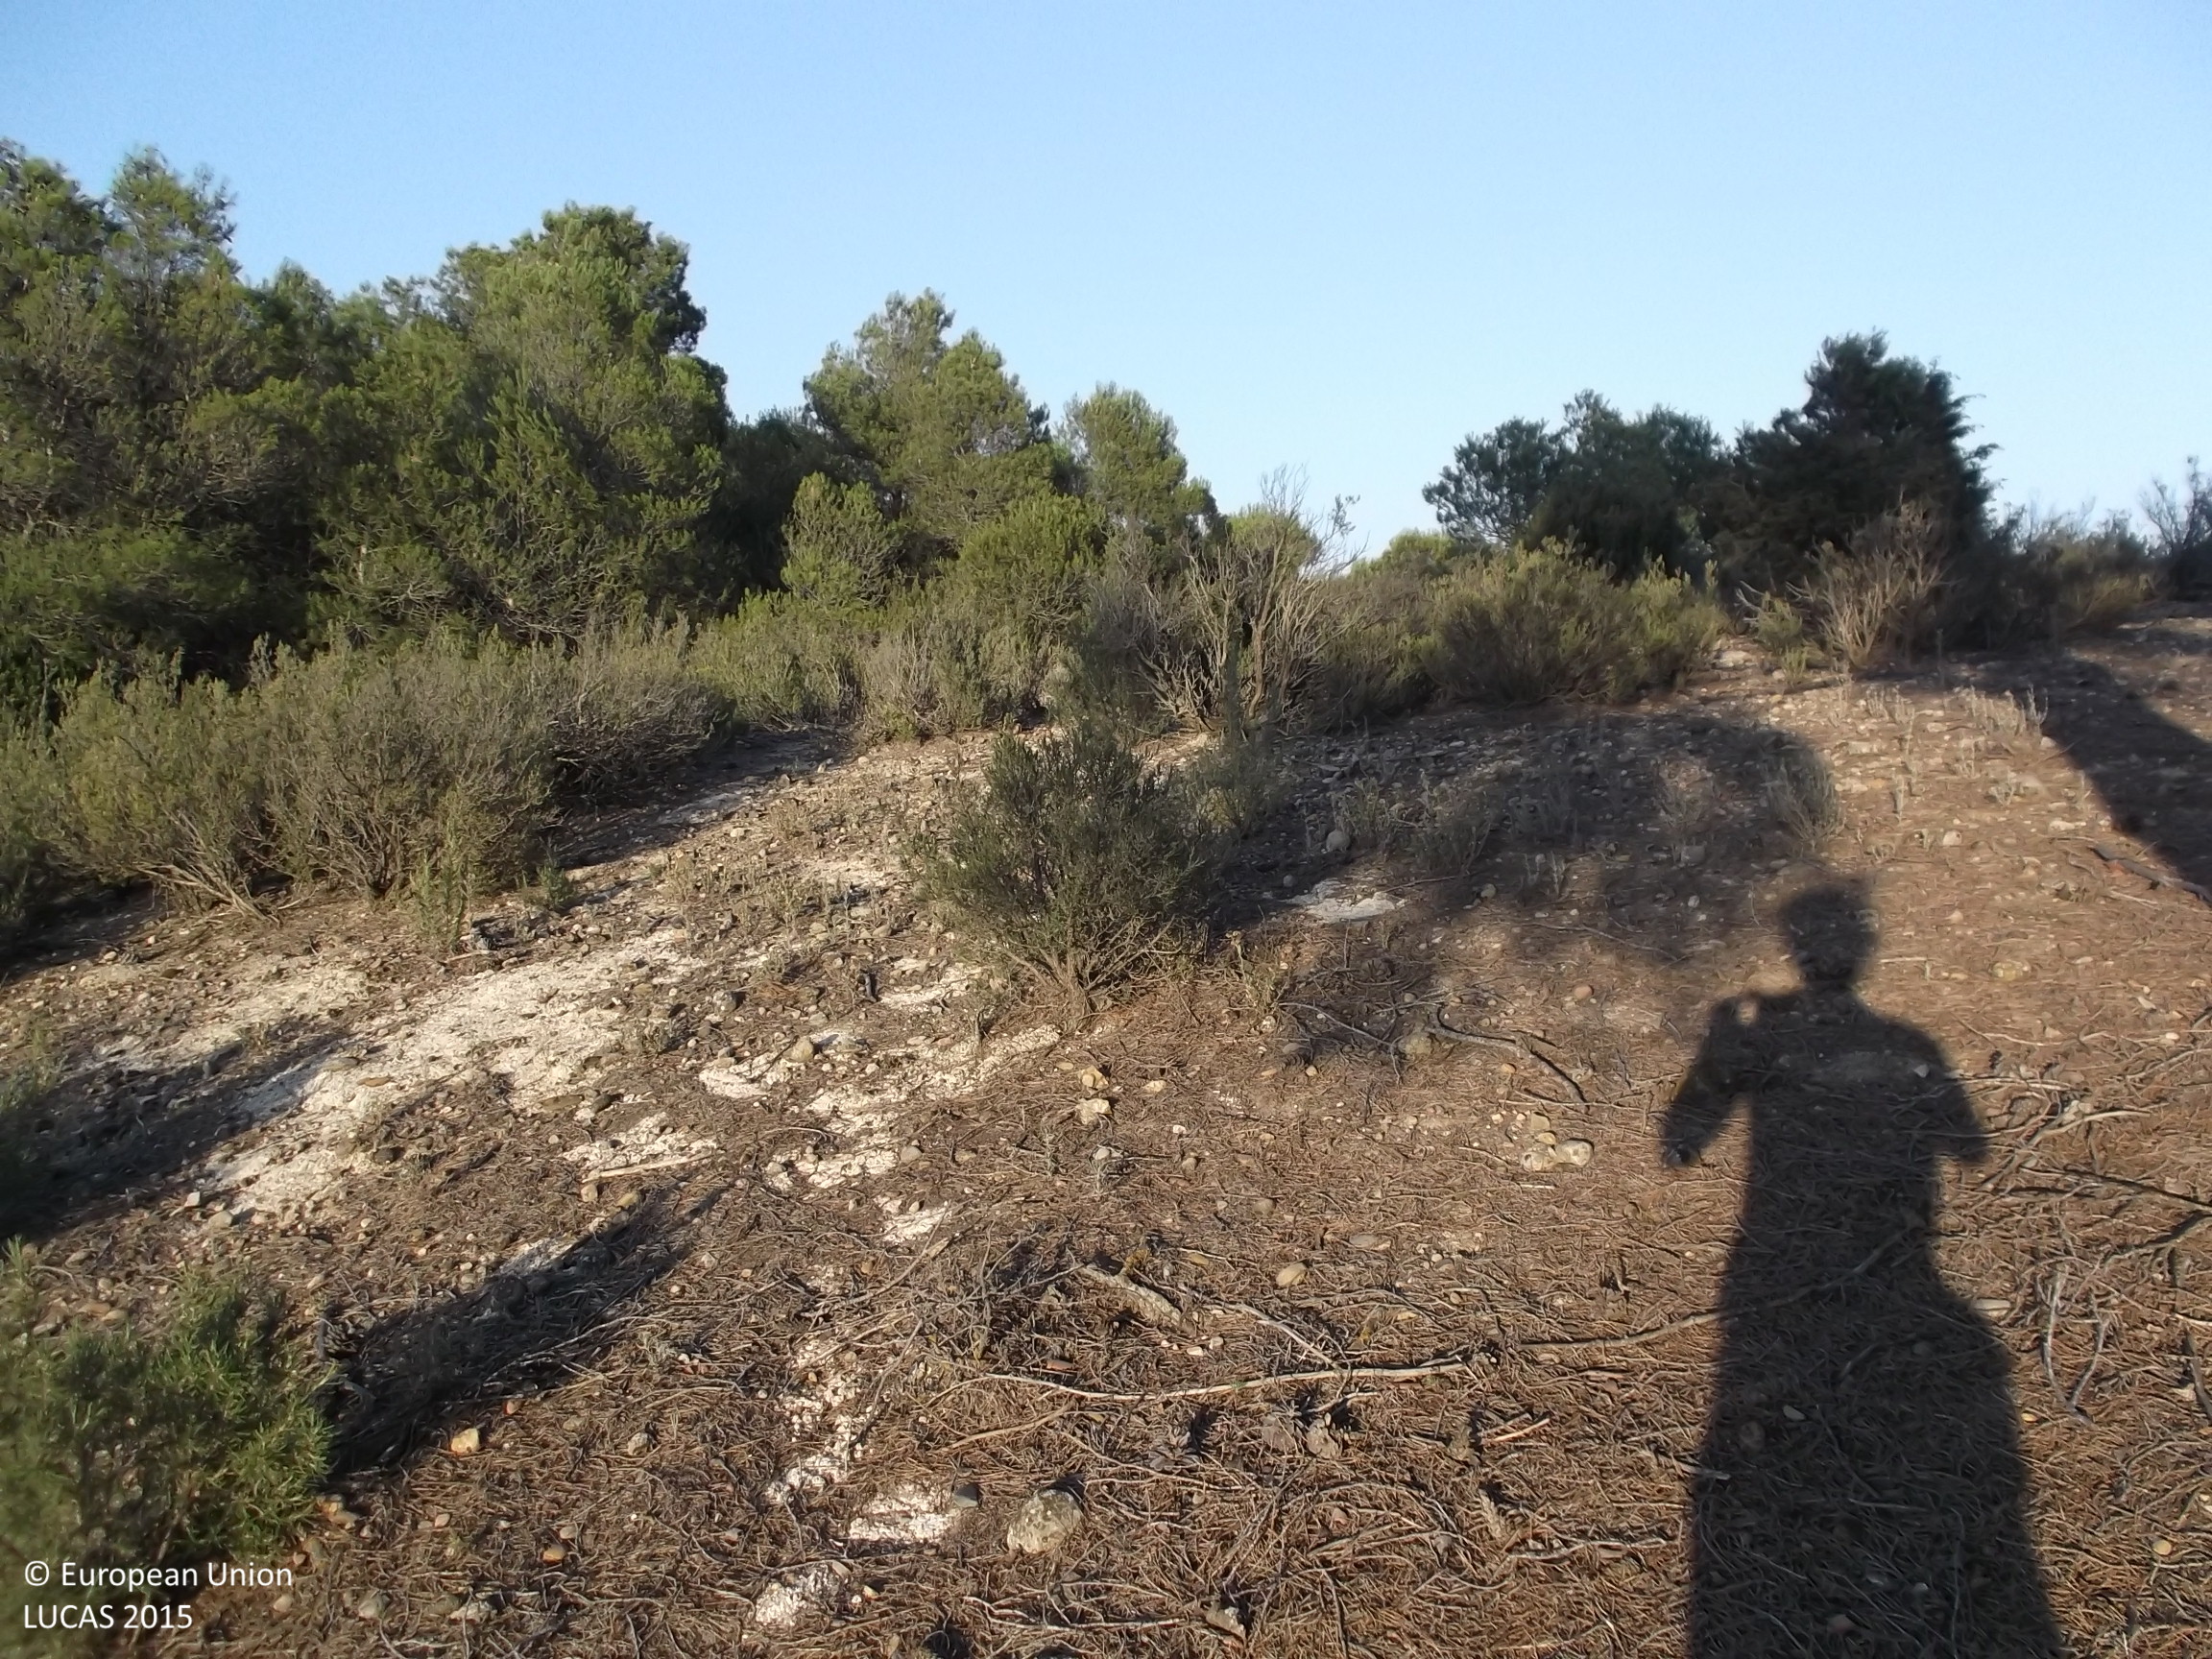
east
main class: Woodland
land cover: Pine dominated coniferous woodland
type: coniferous forest of the mediterranean region
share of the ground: > 75 %
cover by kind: coniferous forest trees 75 %, shrubs 10 %, unconsolidated bare surface 10 %, herbaceous plants 5 %
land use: Semi-natural and natural areas not in use
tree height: > 5 m
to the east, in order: Pine dominated coniferous woodland; Spontaneously vegetated surfaces; Tracks; Barley
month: July
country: ES
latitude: 42.2903
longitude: -1.6409
